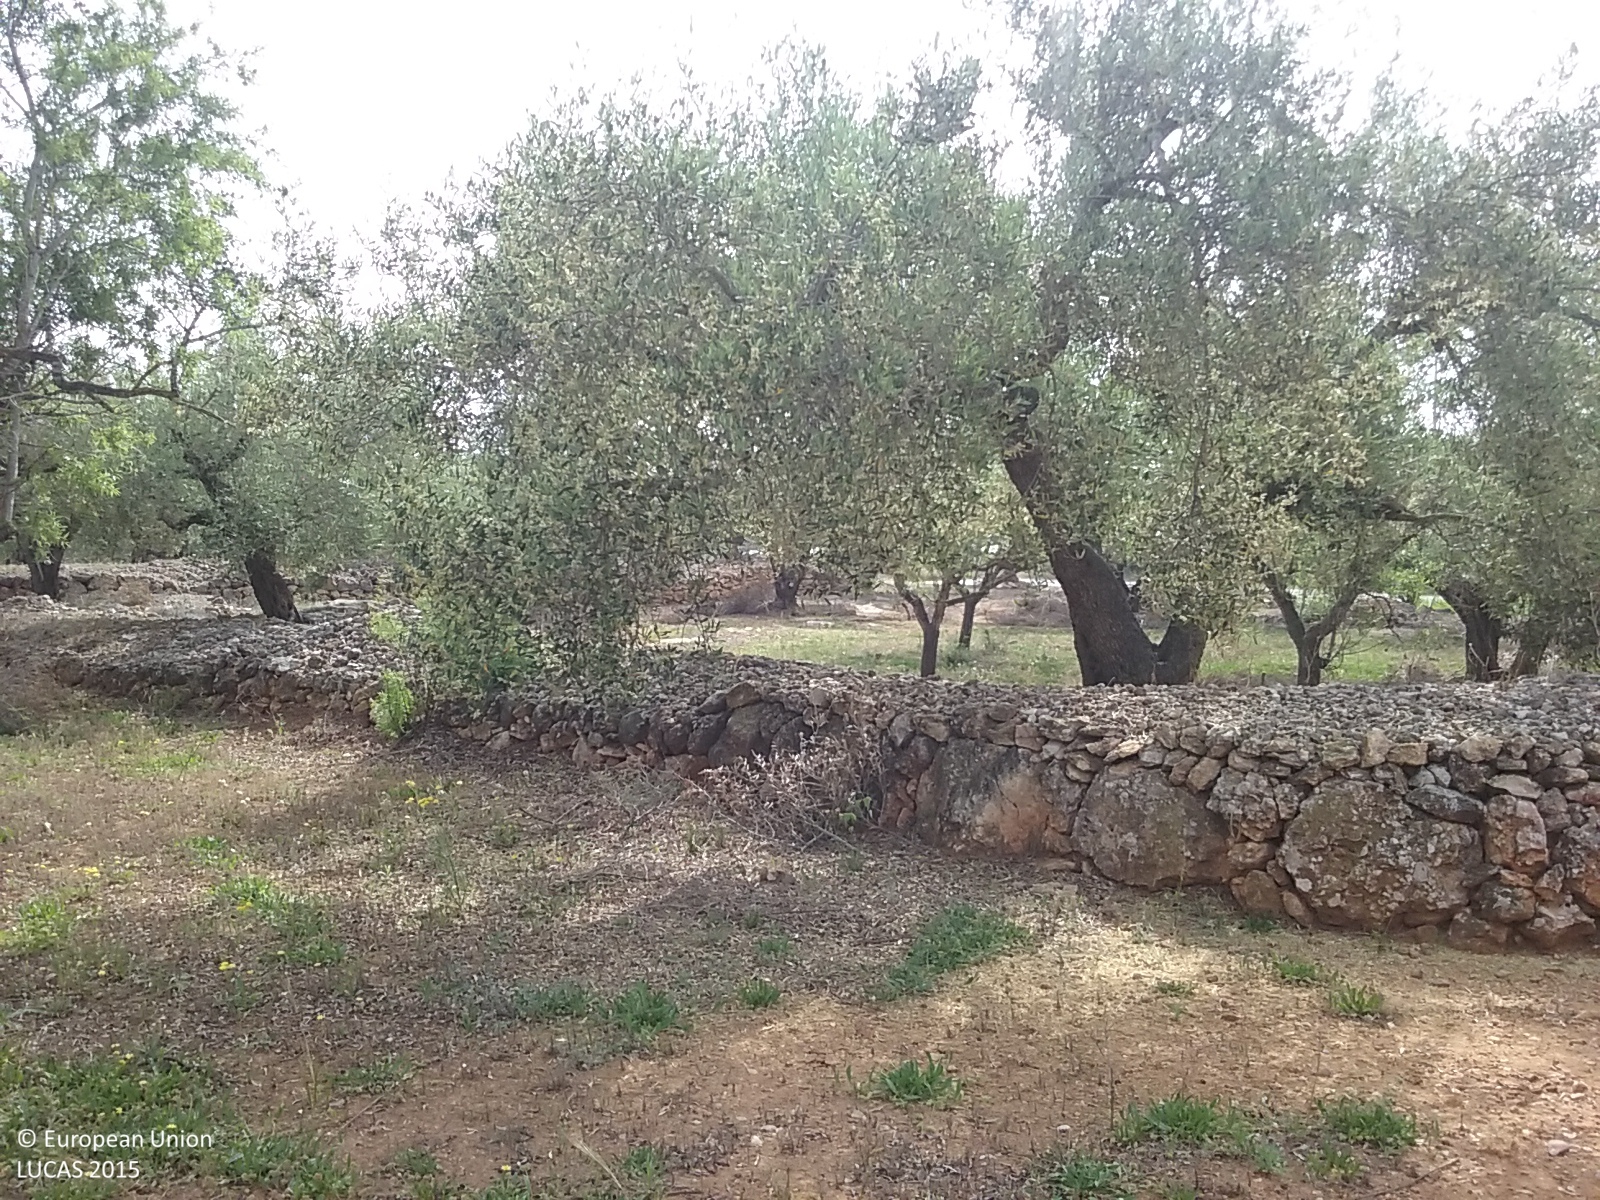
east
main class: Cropland
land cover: Olive groves
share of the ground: 25 - 50 %
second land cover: Spontaneously vegetated surfaces
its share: 25 - 50 %
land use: Agriculture (excluding fallow land and kitchen gardens)
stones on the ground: 25 - 50 %
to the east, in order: Olive groves; Spontaneously vegetated surfaces; Dry stone walls; Olive groves; Dry stone walls; Olive groves; Dry stone walls; Olive groves; Paved roads, cycling and walking lanes; Shruby margins; Fences; Shrubland with sparse tree cover; Paved roads, cycling and walking lanes; Managed hedges; Paved roads, cycling and walking lanes; Groves; Paved roads, cycling and walking lanes; Artificial constructions in urban areas
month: May
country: ES
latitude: 40.7638
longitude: 0.6242
